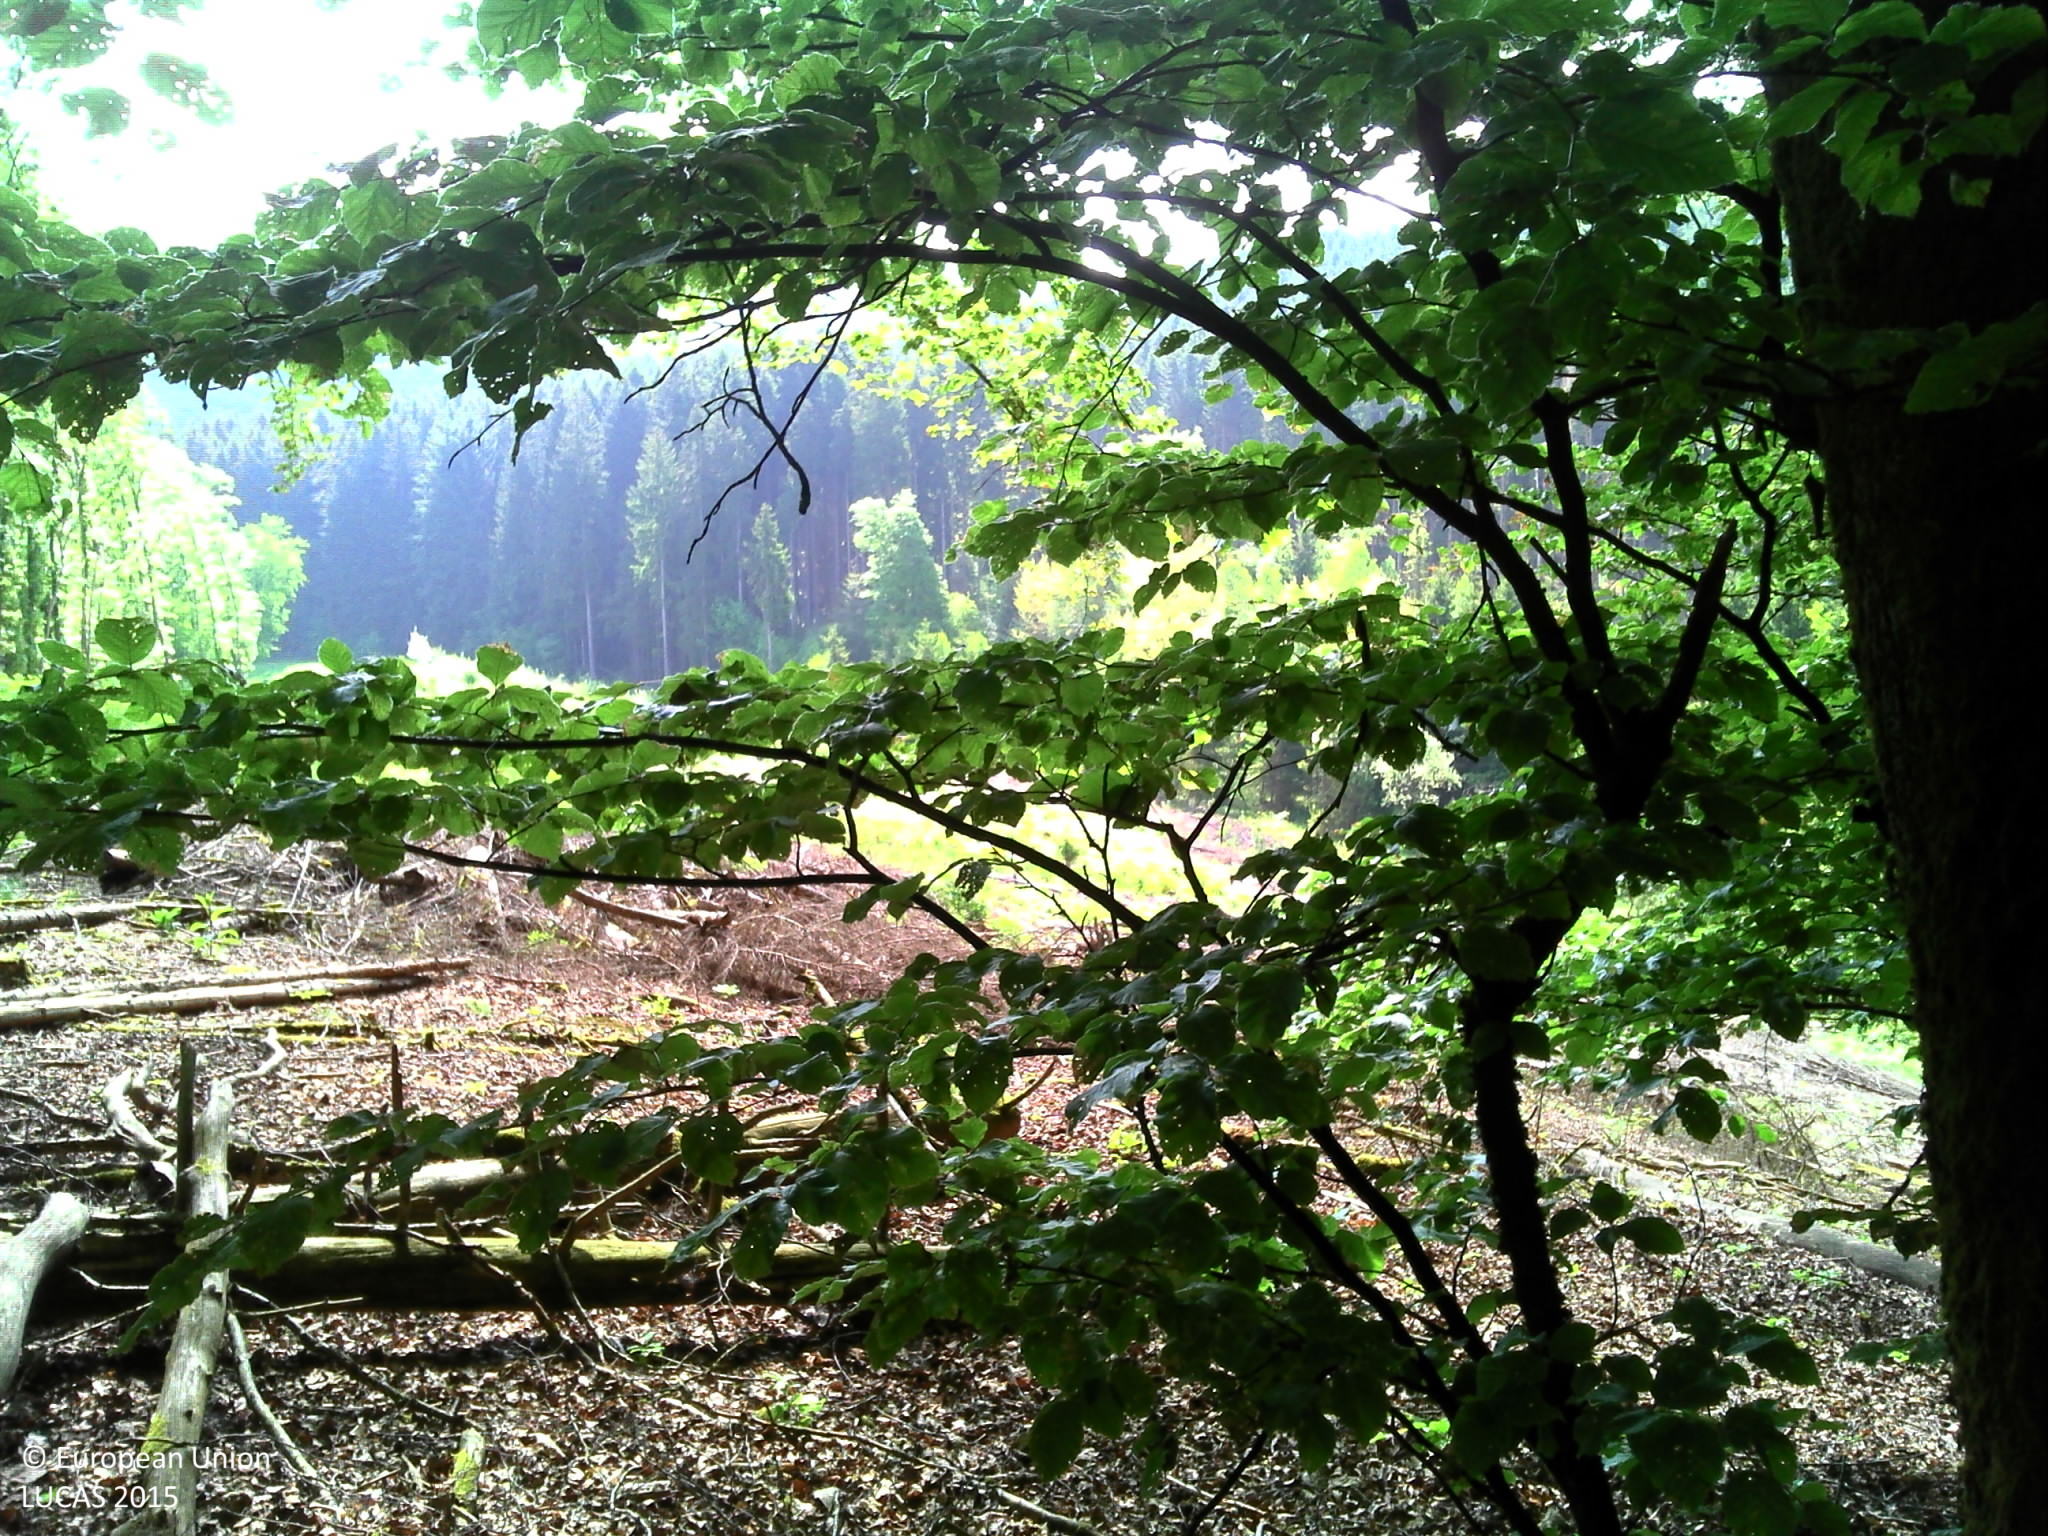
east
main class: Woodland
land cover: Broadleaved woodland
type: acidophilous oak and oak-birch forest
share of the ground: > 75 %
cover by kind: broadleaved forest trees 95 %, lichens and mosses 5 %
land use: Forestry
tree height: > 5 m
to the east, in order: Broadleaved woodland; Spontaneously vegetated surfaces; Spruce dominated coniferous woodland; Tracks; Broadleaved woodland; Fences; Grassland without tree/shrub cover; Broadleaved woodland; Grassland without tree/shrub cover
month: May
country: LU
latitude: 49.8802
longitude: 6.0051
